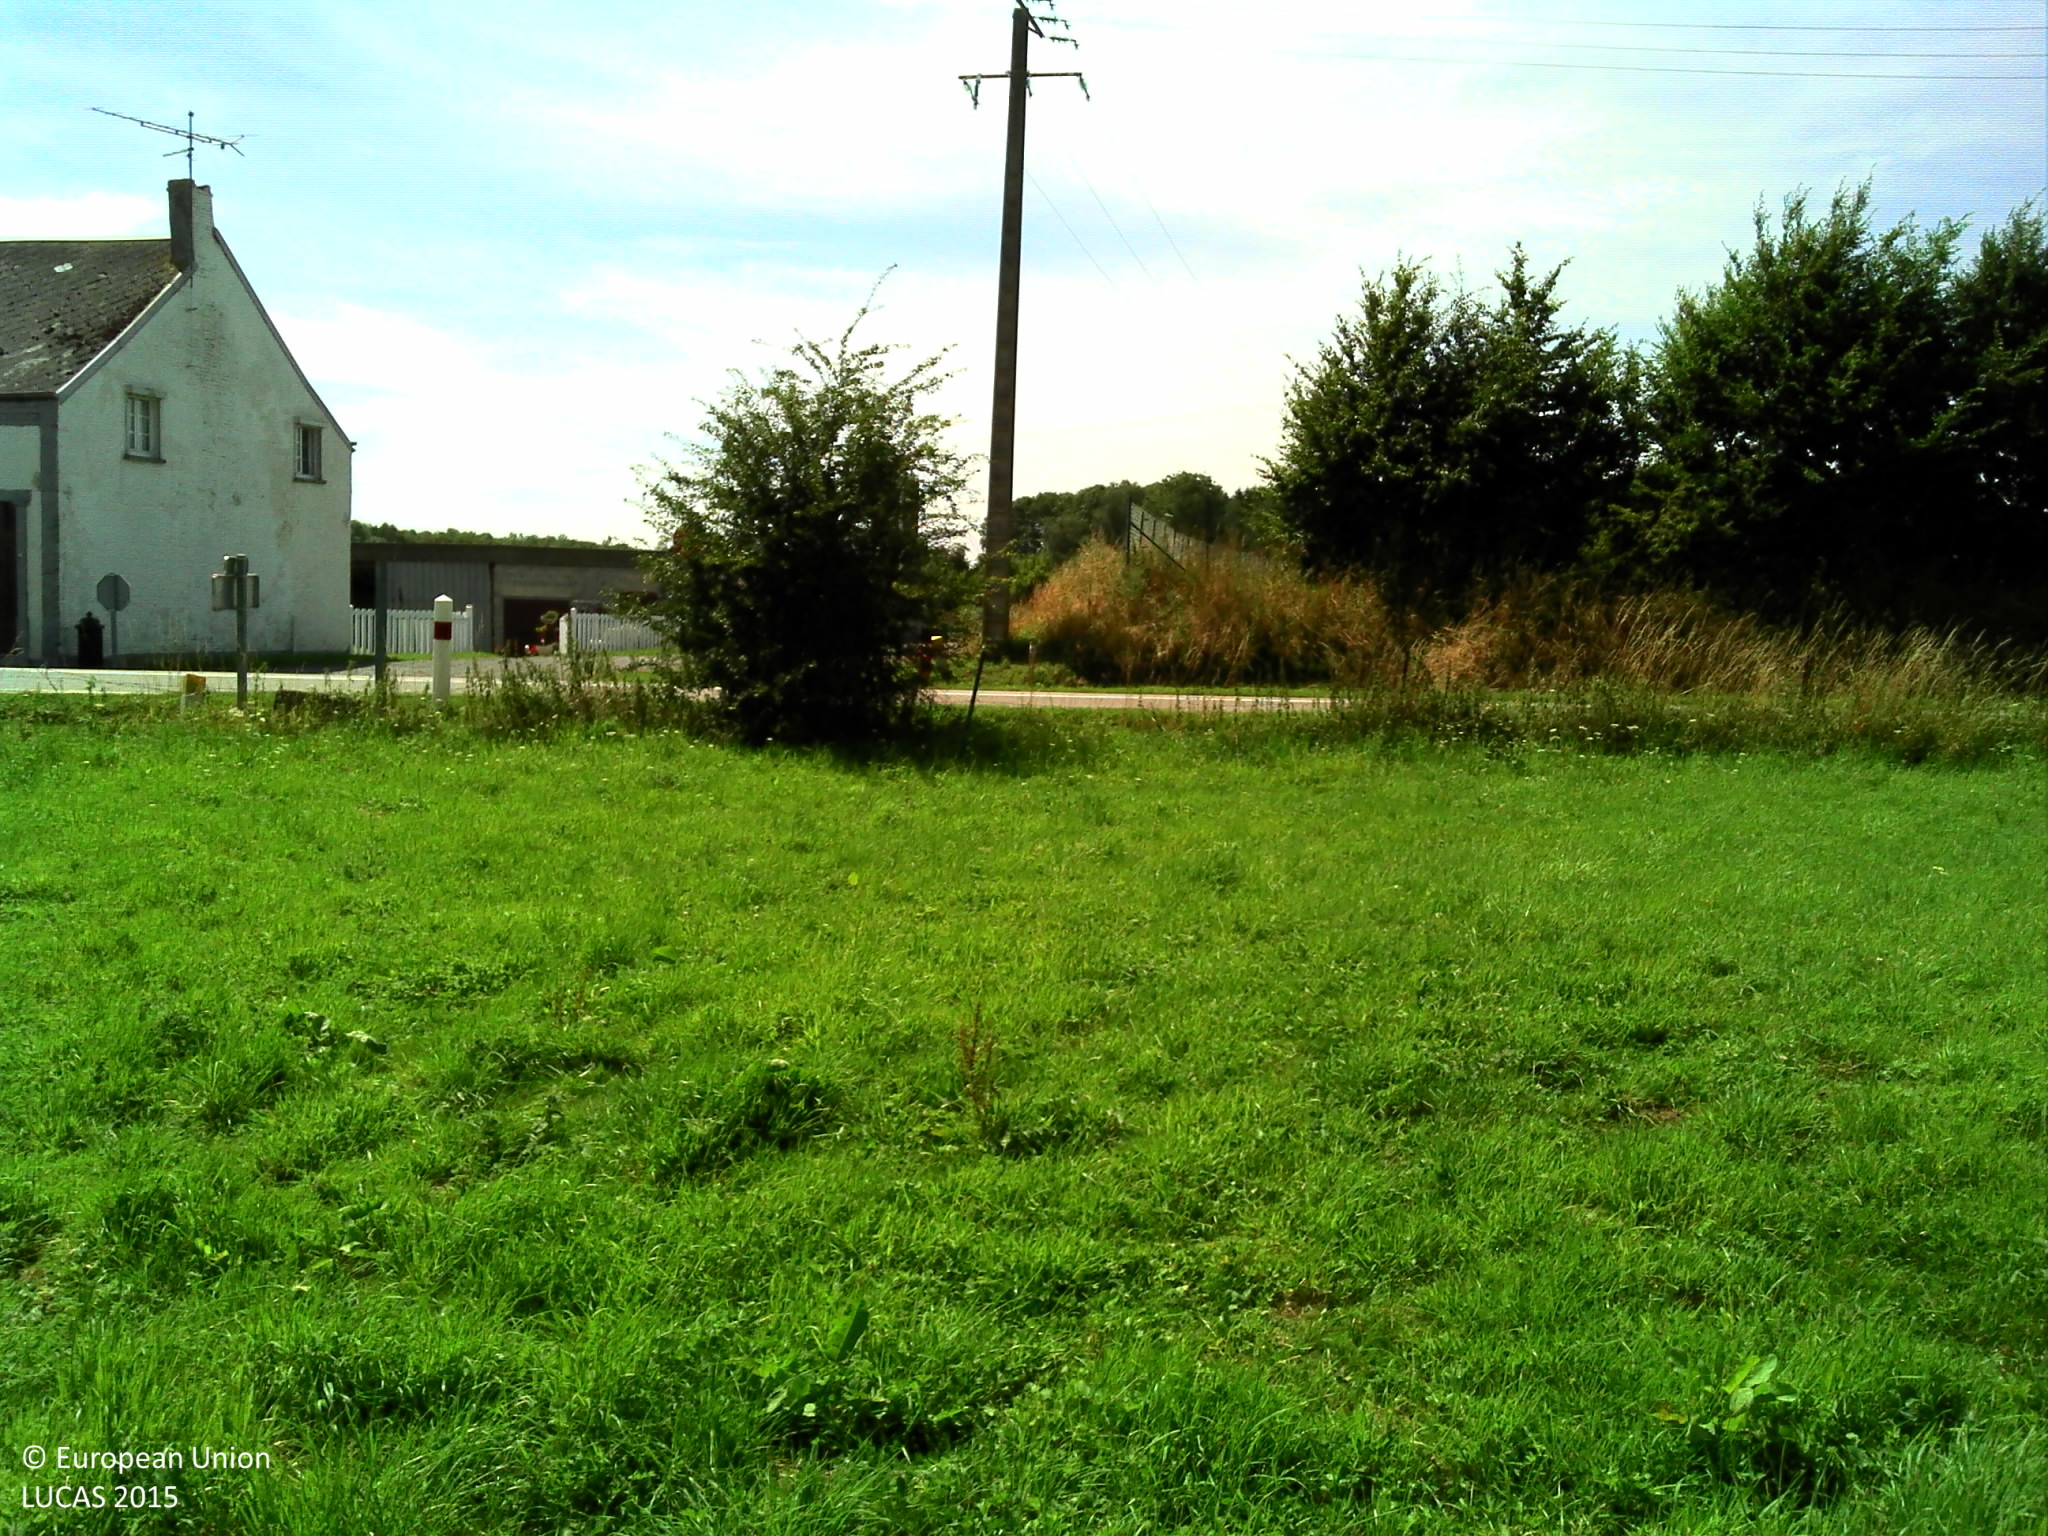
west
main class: Grassland
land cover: Grassland without tree/shrub cover
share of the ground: > 75 %
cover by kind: herbaceous plants 100 %
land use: Agriculture (excluding fallow land and kitchen gardens)
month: August
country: FR
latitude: 50.0503
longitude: 4.1152
